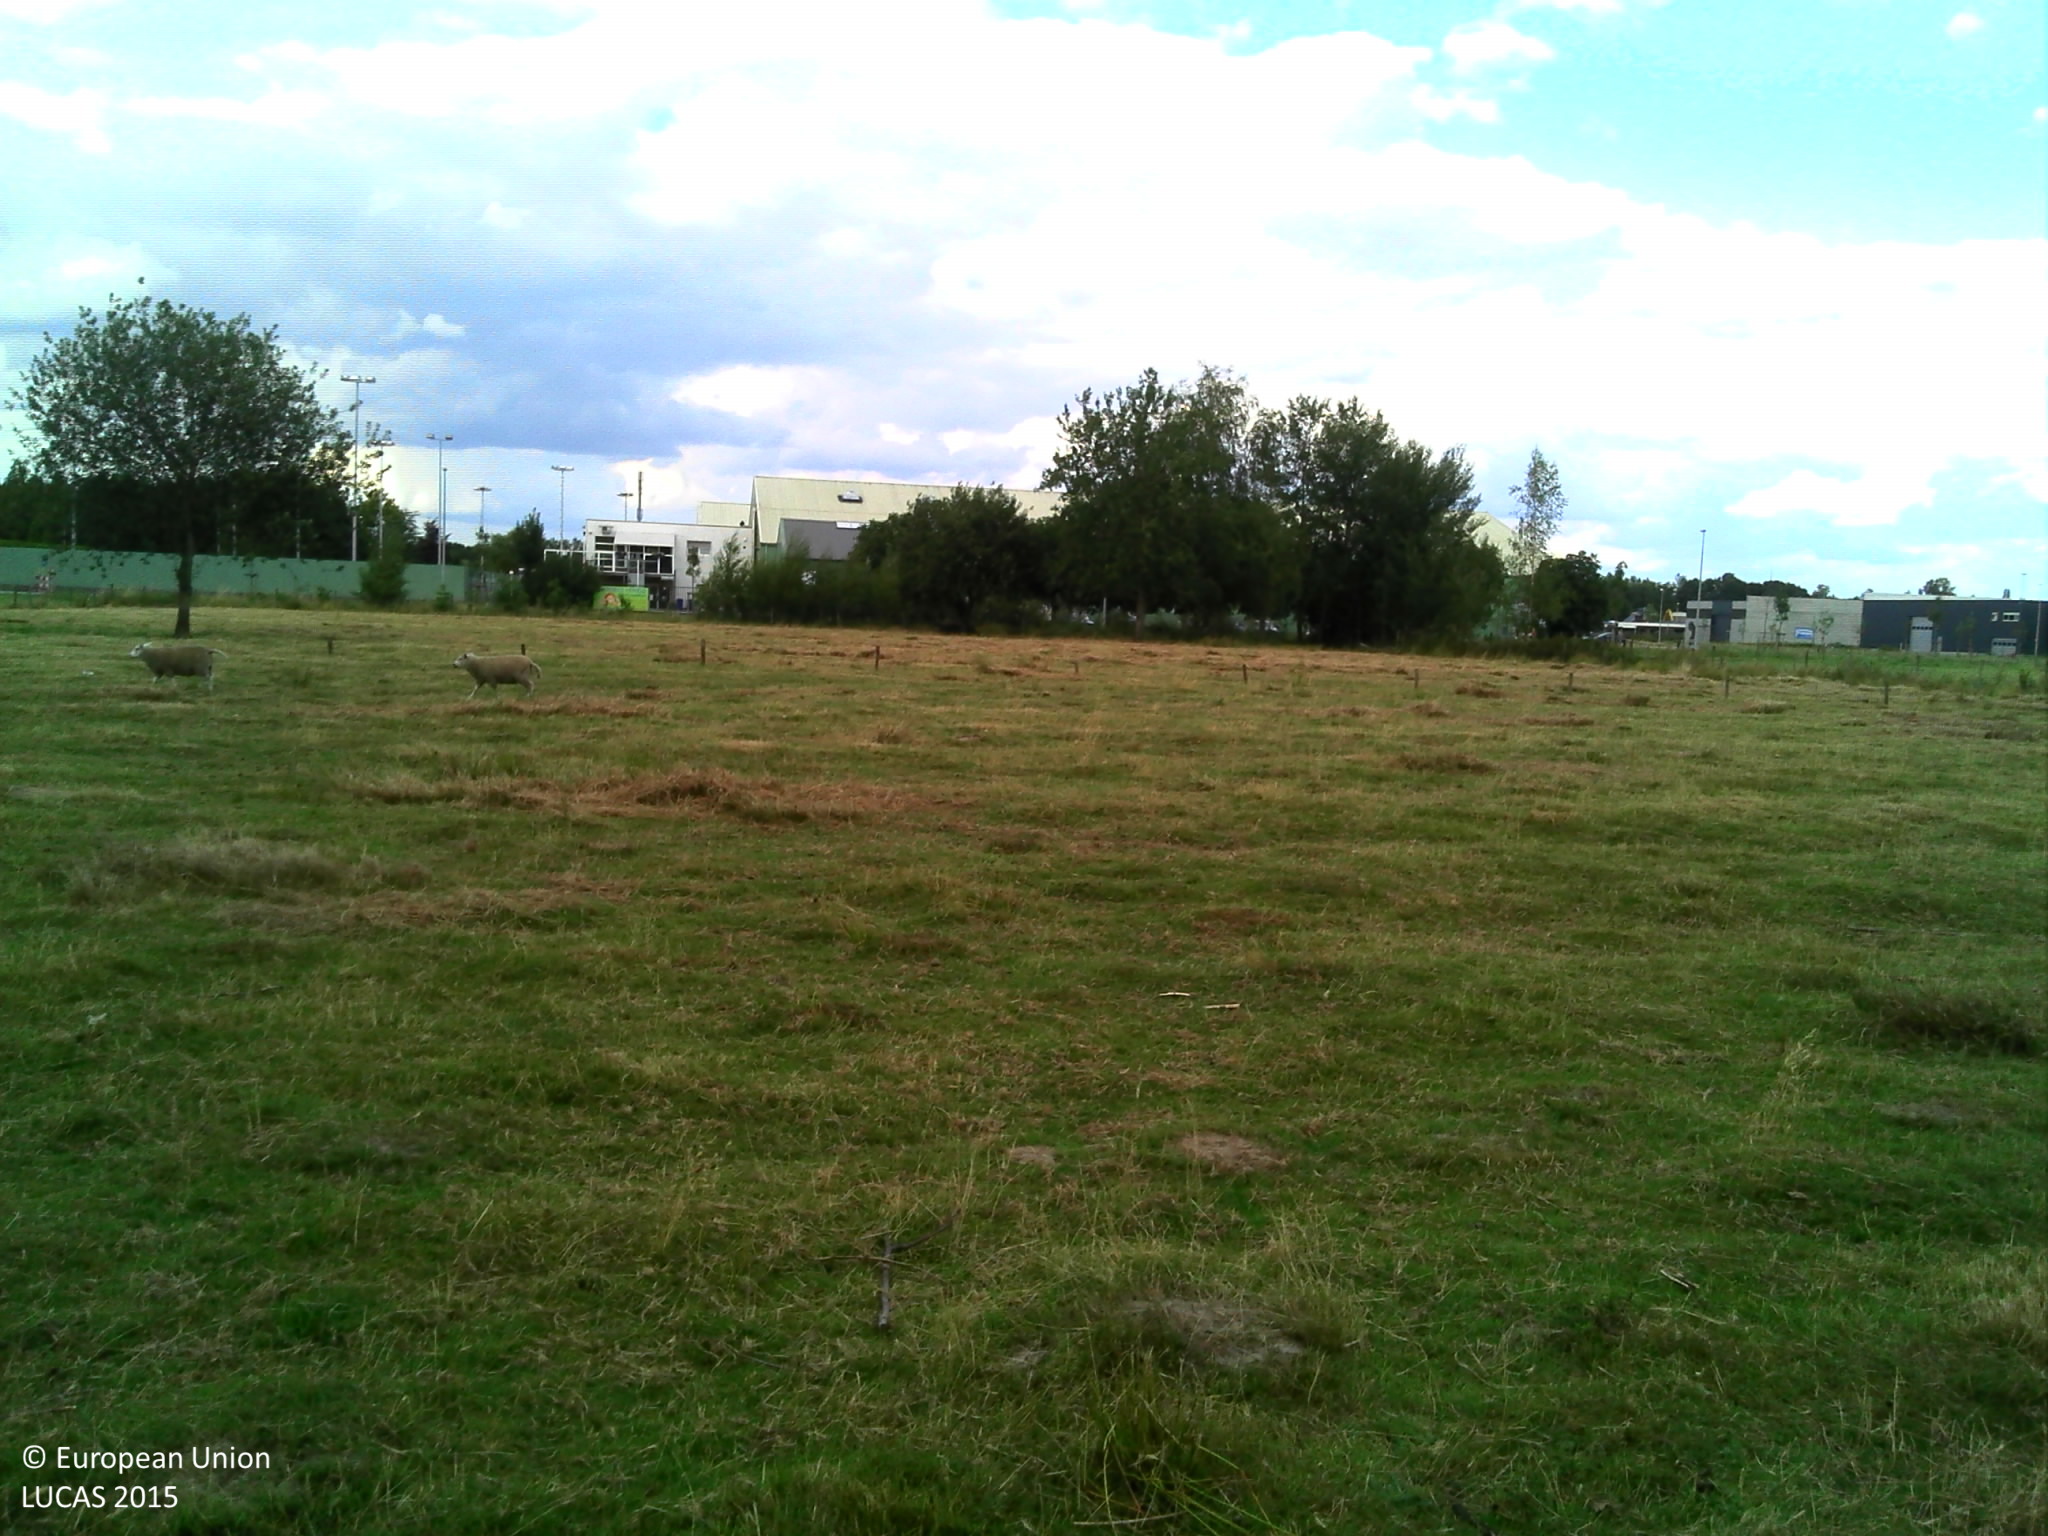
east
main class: Woodland
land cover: Broadleaved woodland
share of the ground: > 75 %
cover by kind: broadleaved forest trees 80 %, coniferous forest trees 10 %, shrubs 10 %
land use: Semi-natural and natural areas not in use
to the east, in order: Broadleaved woodland; Artificial constructions in urban areas; Grassland without tree/shrub cover
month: July
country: BE
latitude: 51.0622
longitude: 4.5309
